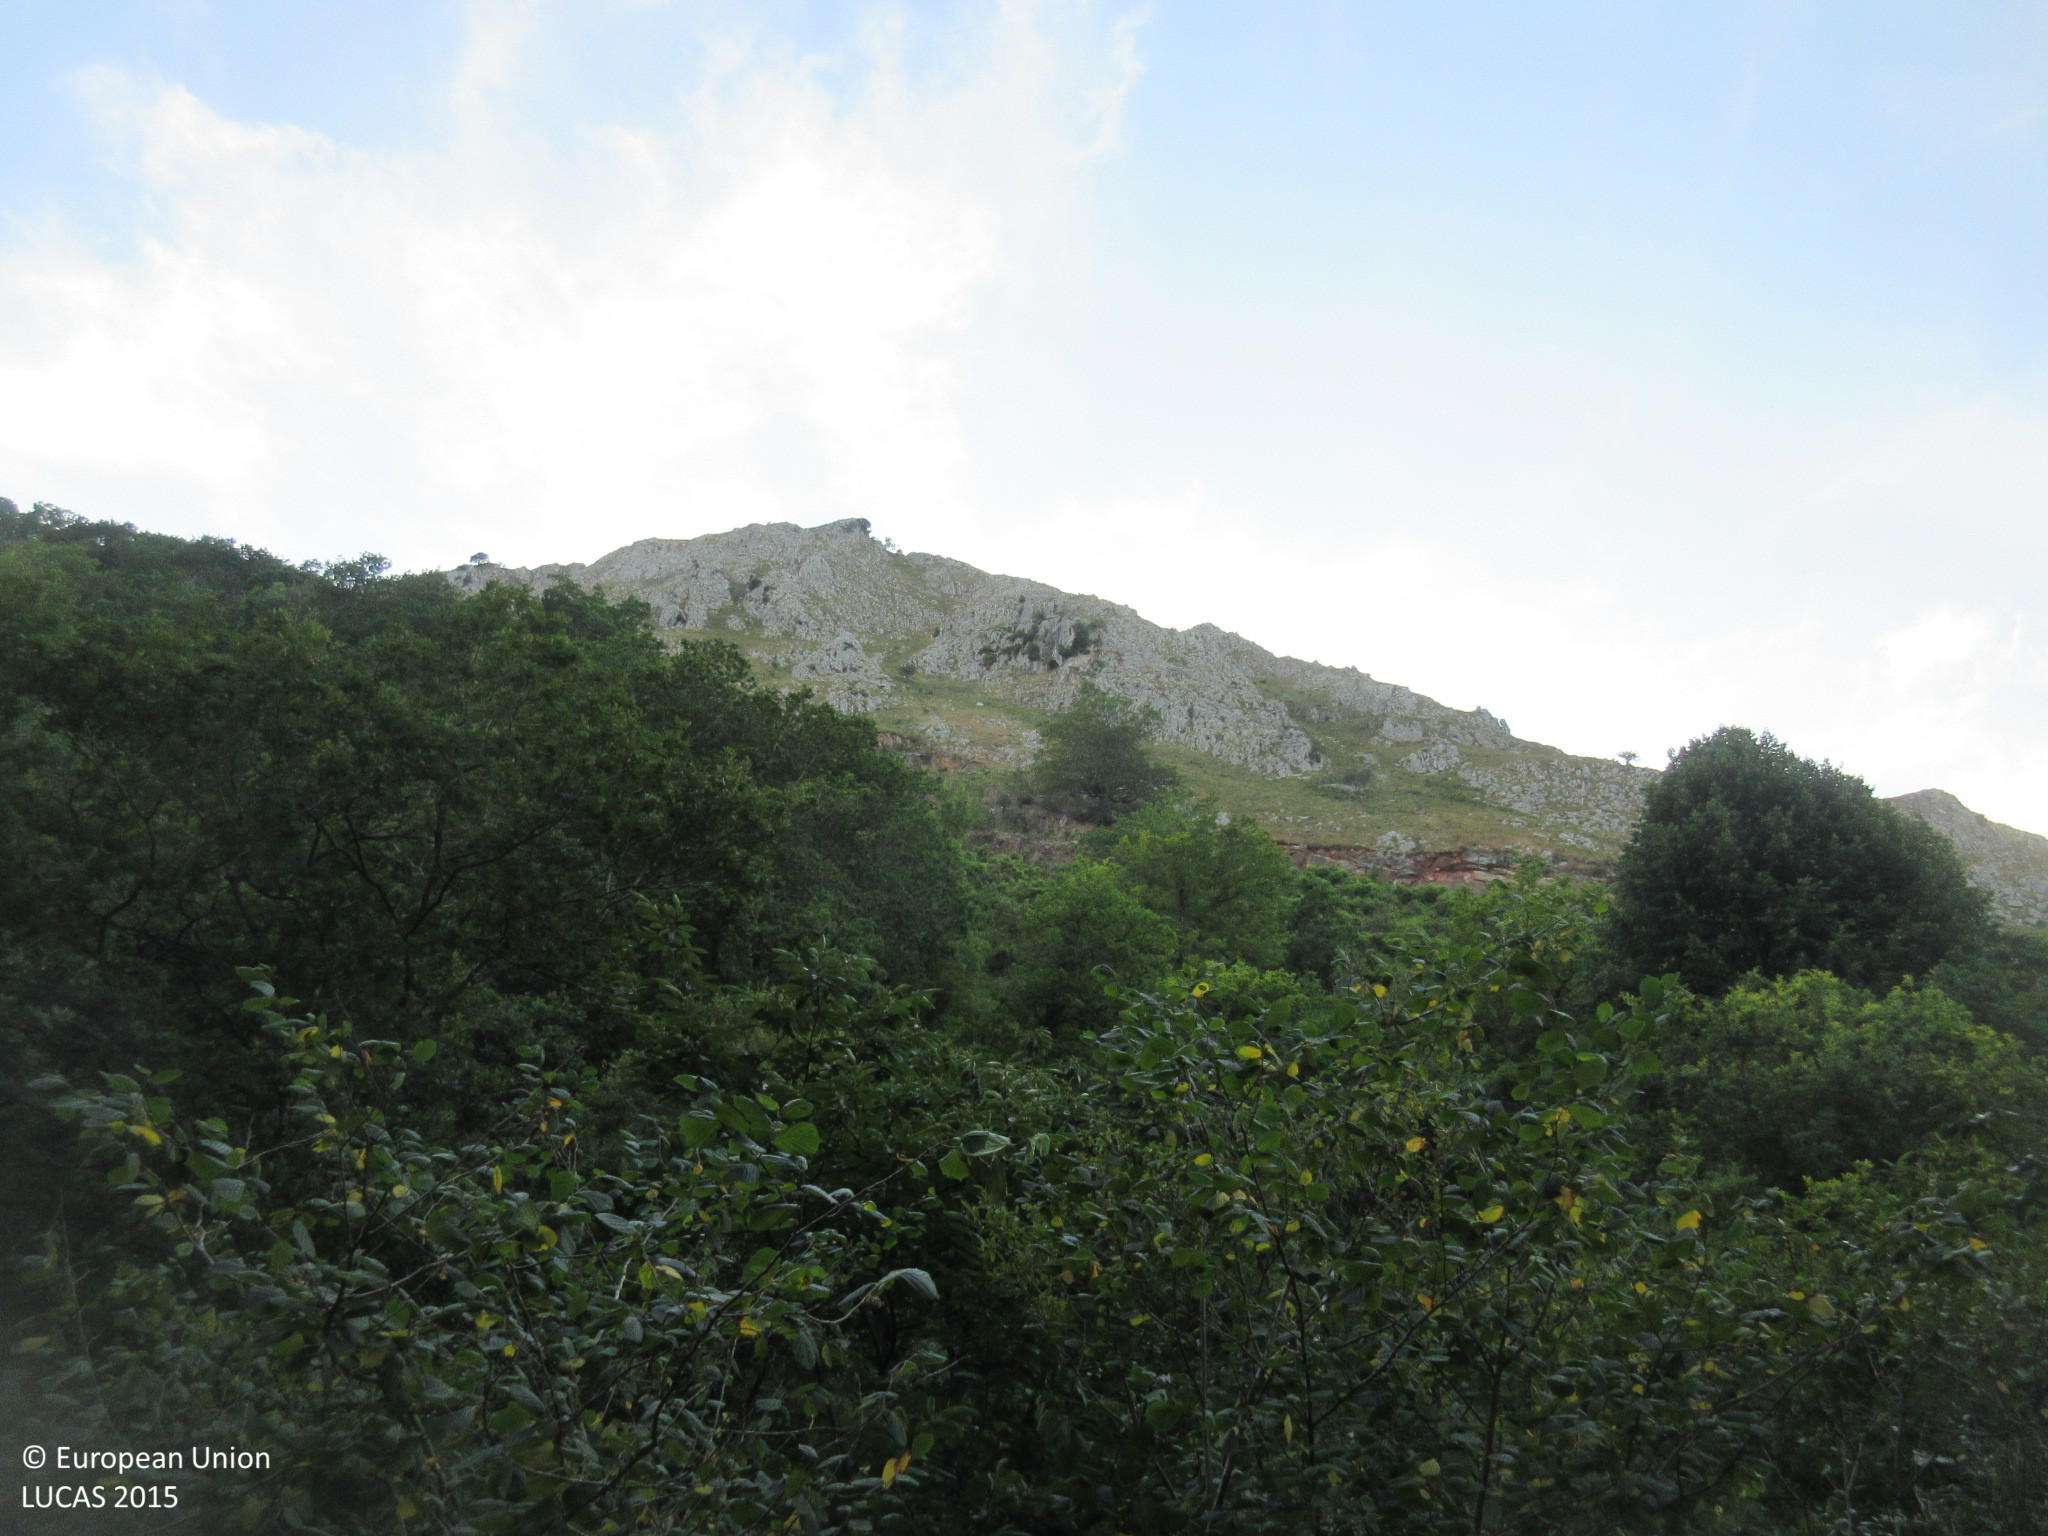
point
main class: Grassland
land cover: Grassland without tree/shrub cover
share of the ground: > 75 %
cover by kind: herbaceous plants 80 %, consolidated bare surface 20 %
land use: Agriculture (excluding fallow land and kitchen gardens)
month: July
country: ES
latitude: 43.3854
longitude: -5.0947
